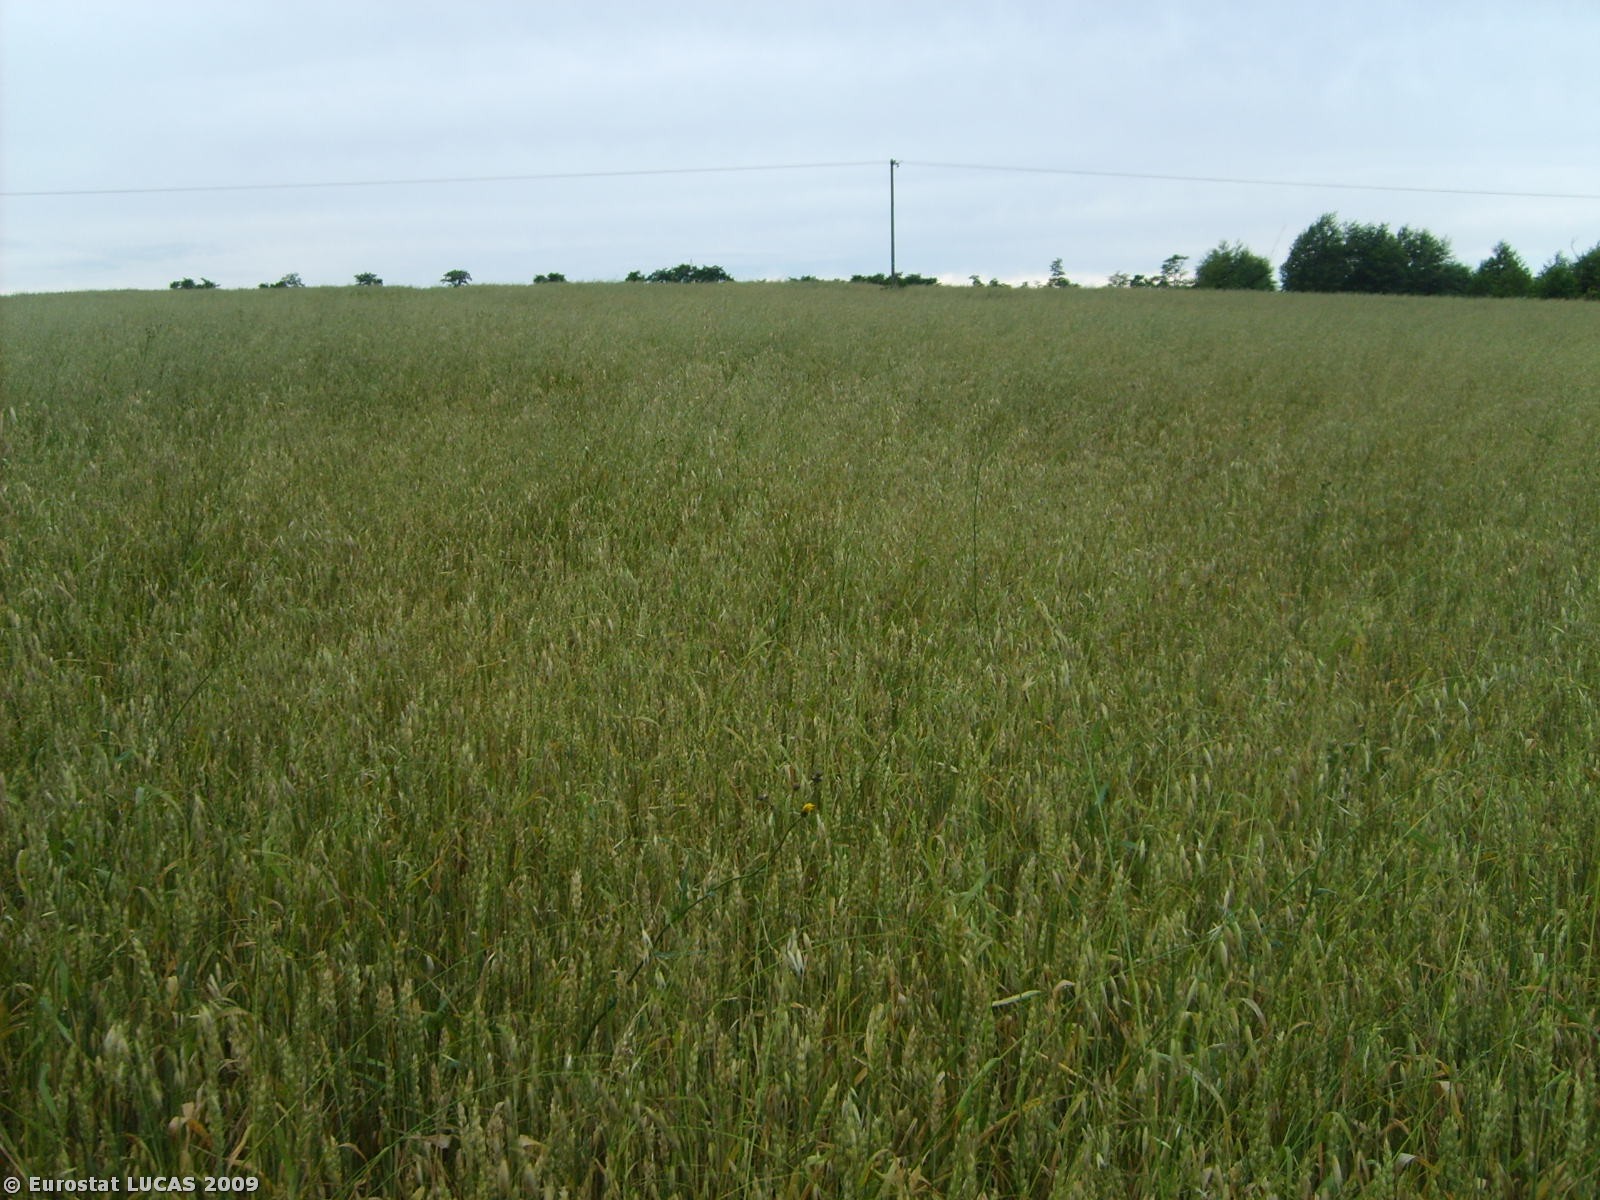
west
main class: Cropland
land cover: Mixed cereals for fodder
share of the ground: > 75 %
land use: Agriculture (excluding fallow land and kitchen gardens)
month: July
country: PL
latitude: 50.3069
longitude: 20.5836
